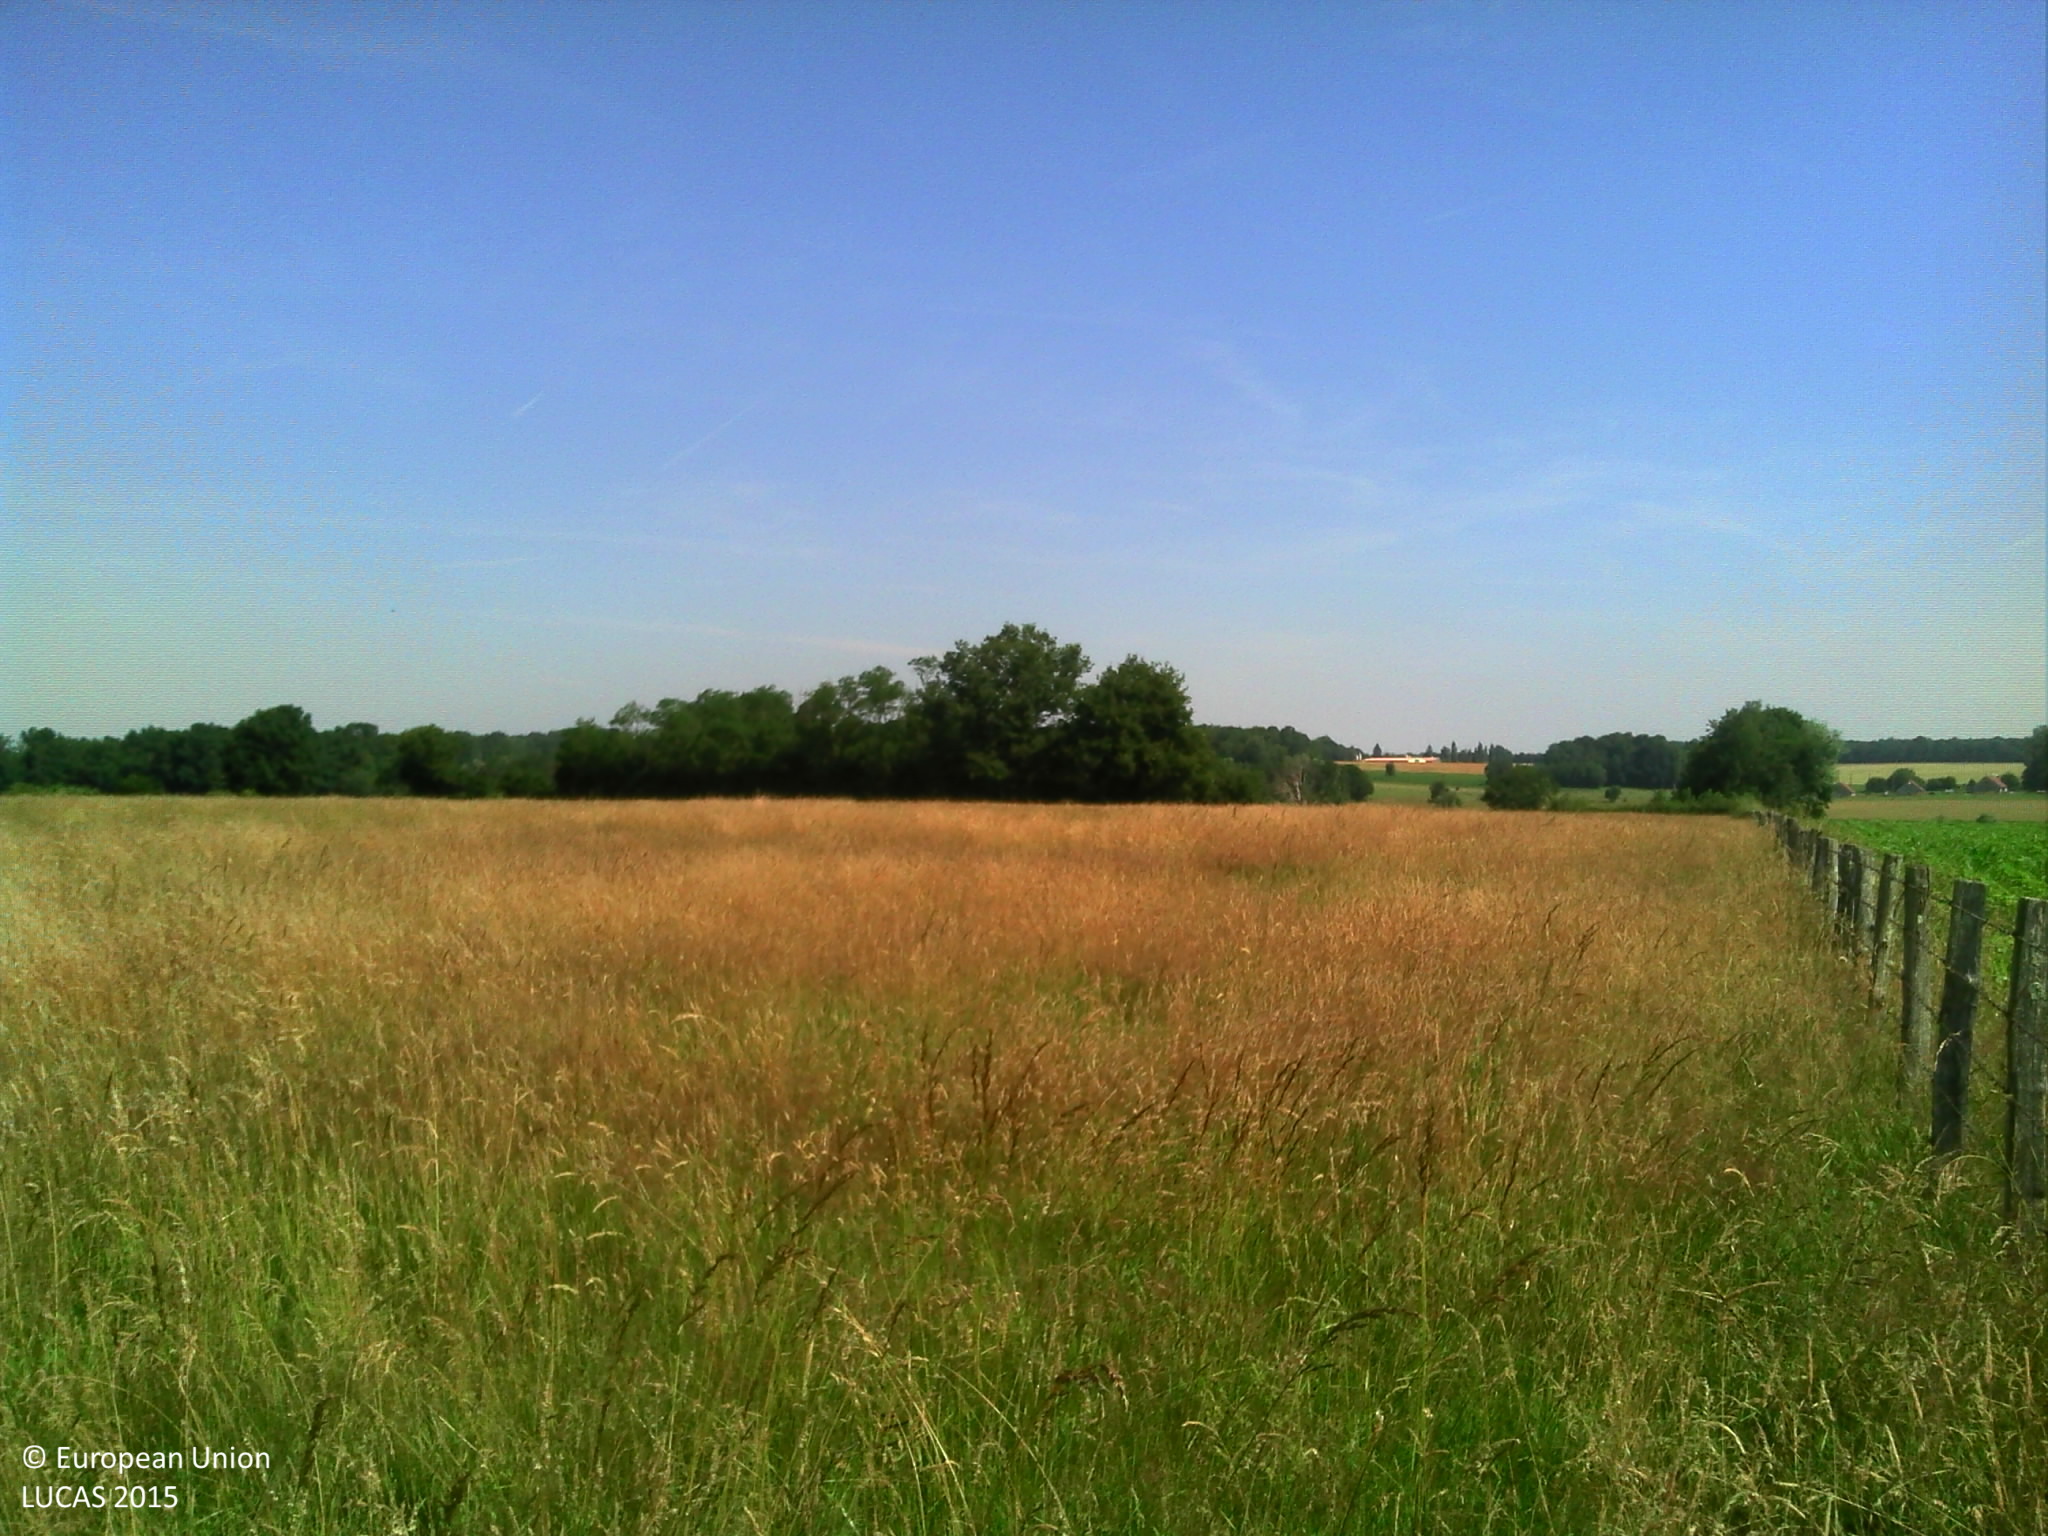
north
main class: Grassland
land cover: Grassland without tree/shrub cover
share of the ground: > 75 %
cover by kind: herbaceous plants 100 %
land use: Agriculture (excluding fallow land and kitchen gardens)
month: June
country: FR
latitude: 46.7543
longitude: 5.3284
